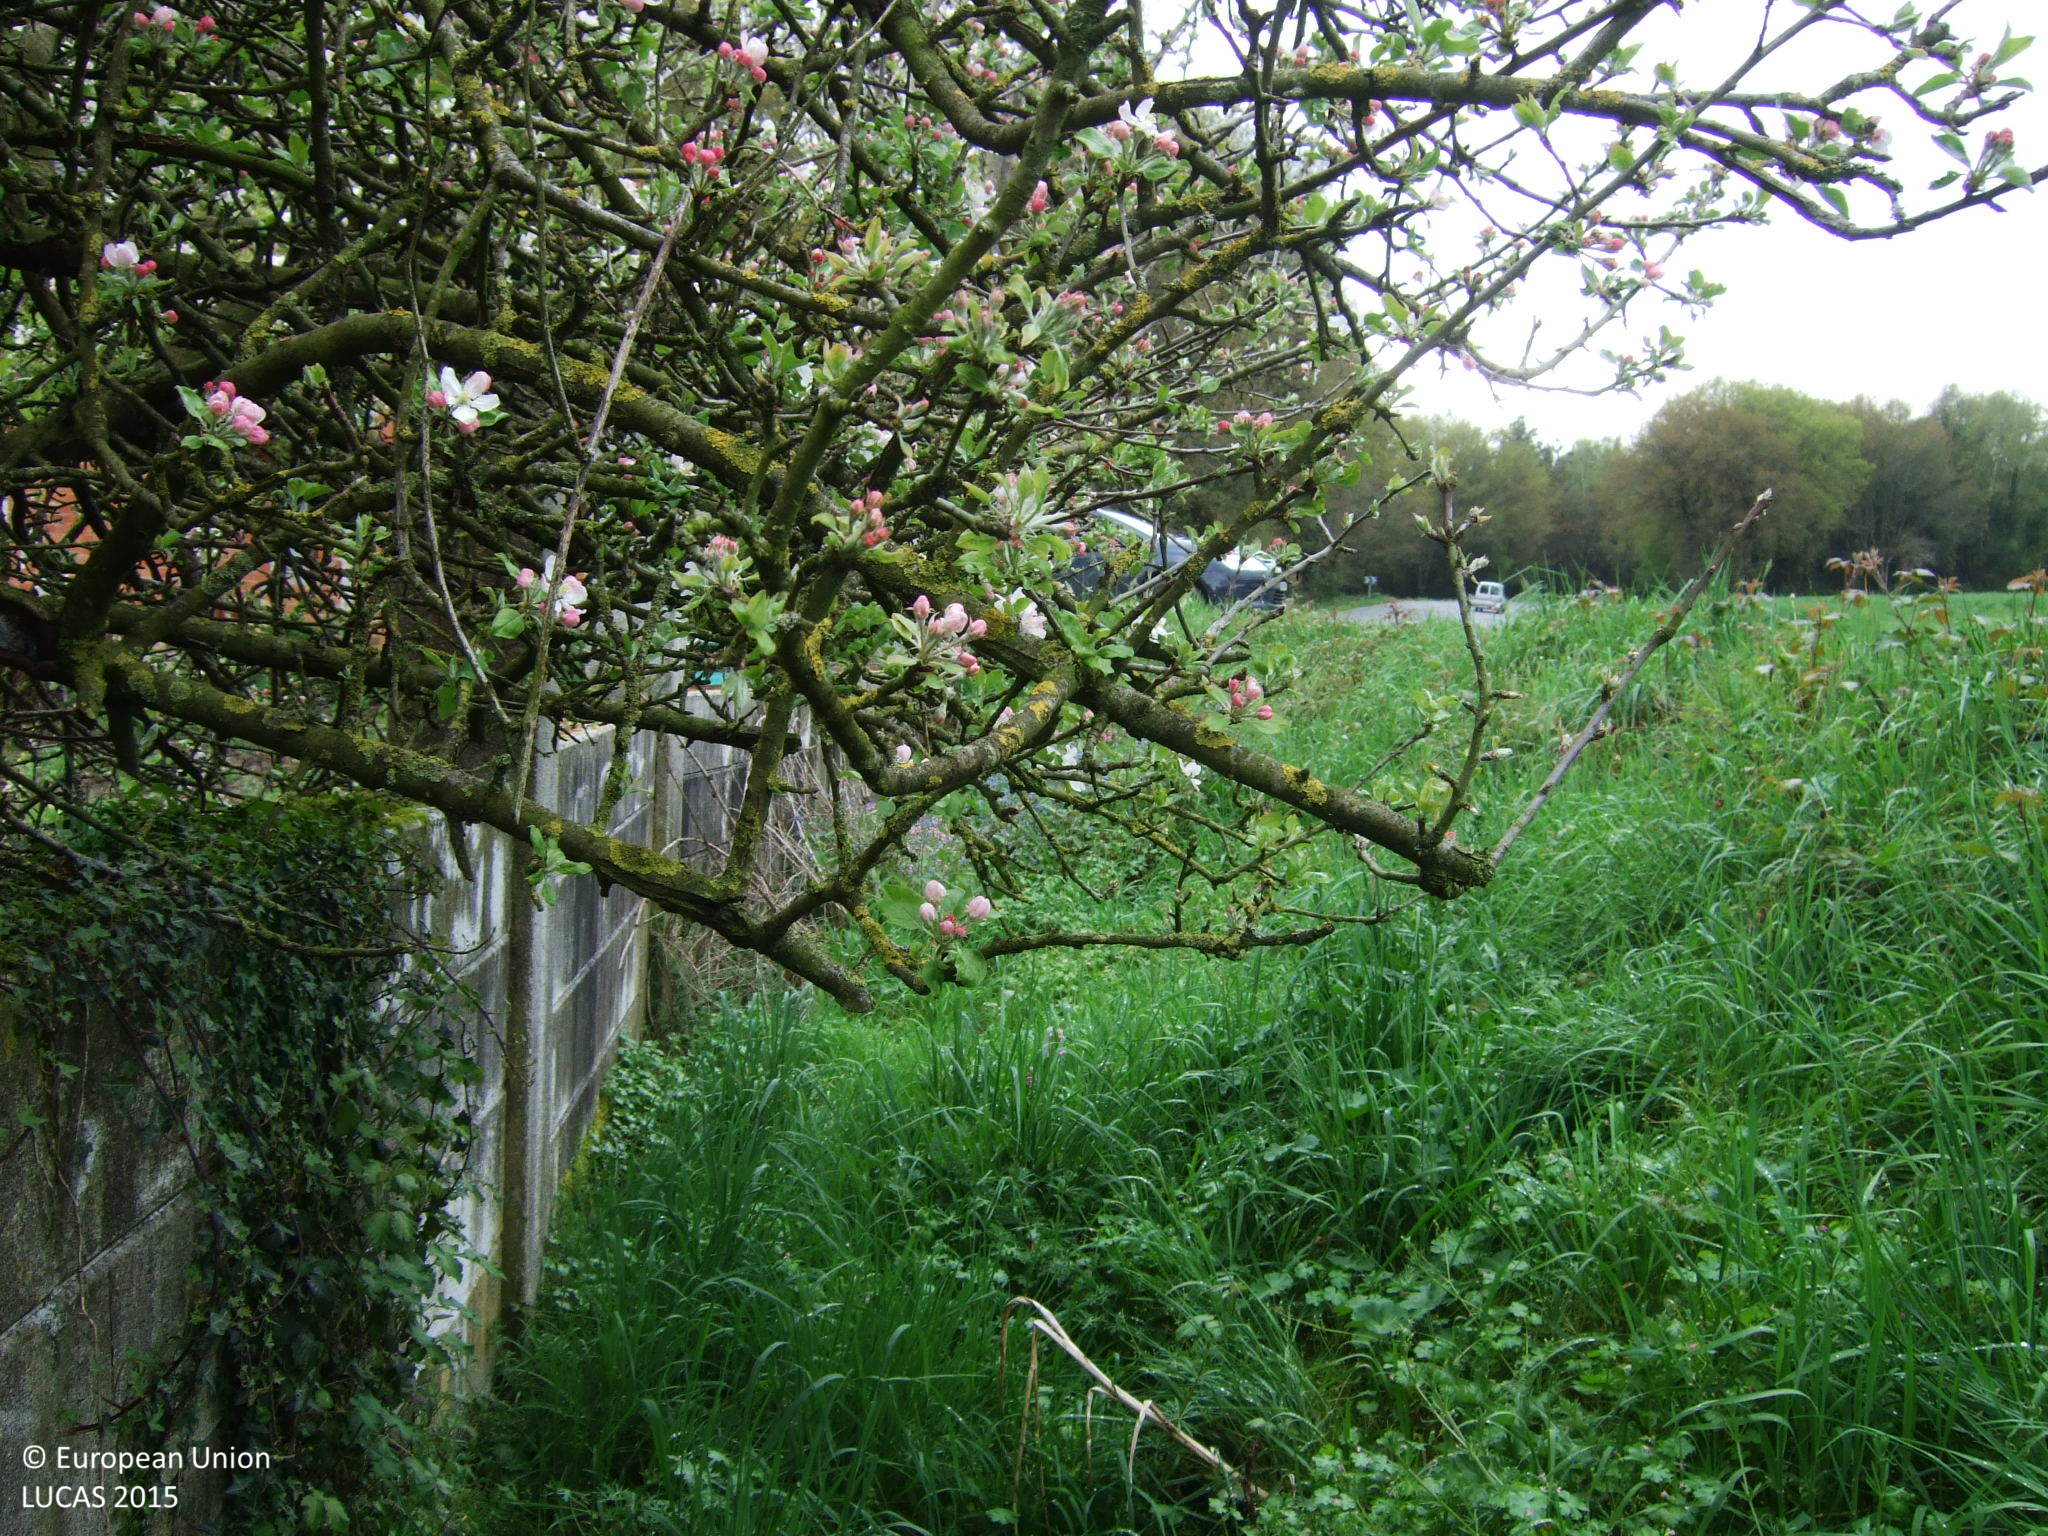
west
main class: Cropland
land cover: Apple fruit
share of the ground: 25 - 50 %
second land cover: Spontaneously vegetated surfaces
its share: > 75 %
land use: Kitchen garden
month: April
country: ES
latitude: 42.8914
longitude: -7.5746
